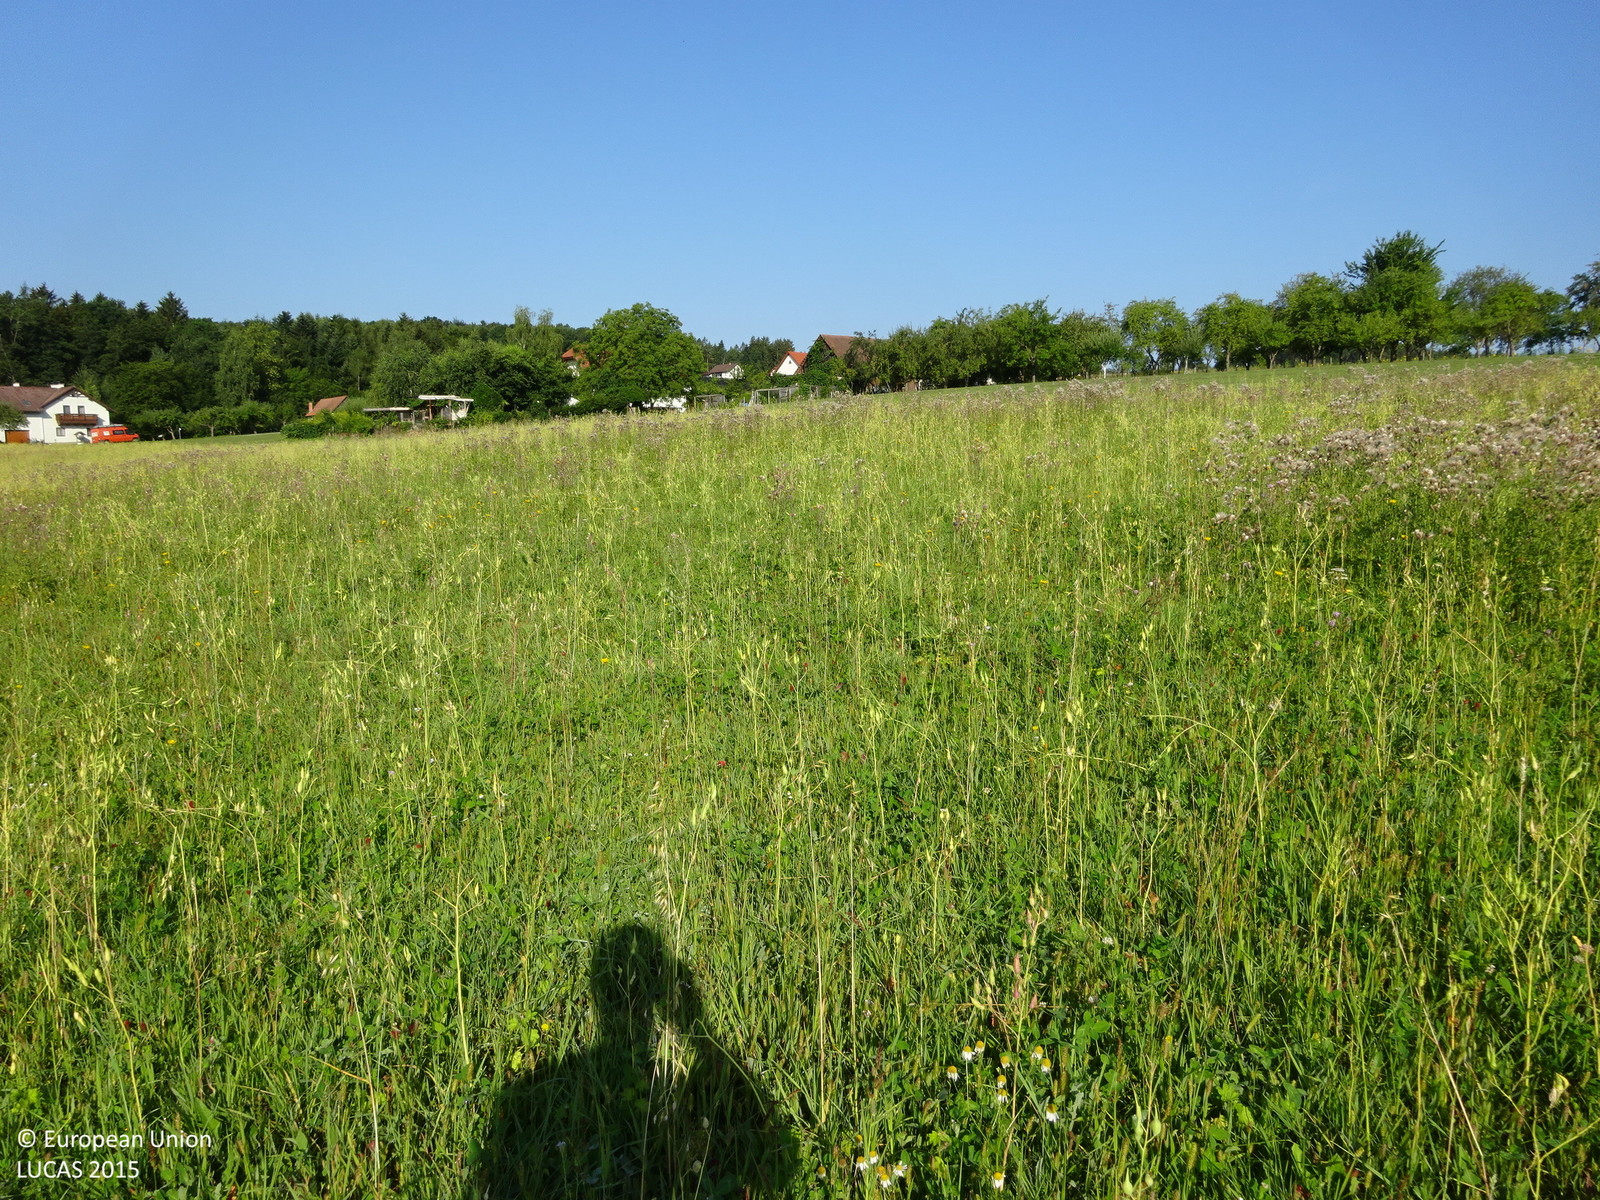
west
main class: Grassland
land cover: Grassland without tree/shrub cover
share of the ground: > 75 %
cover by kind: herbaceous plants 100 %
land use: Agriculture (excluding fallow land and kitchen gardens)
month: August
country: AT
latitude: 47.3908
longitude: 16.0298
